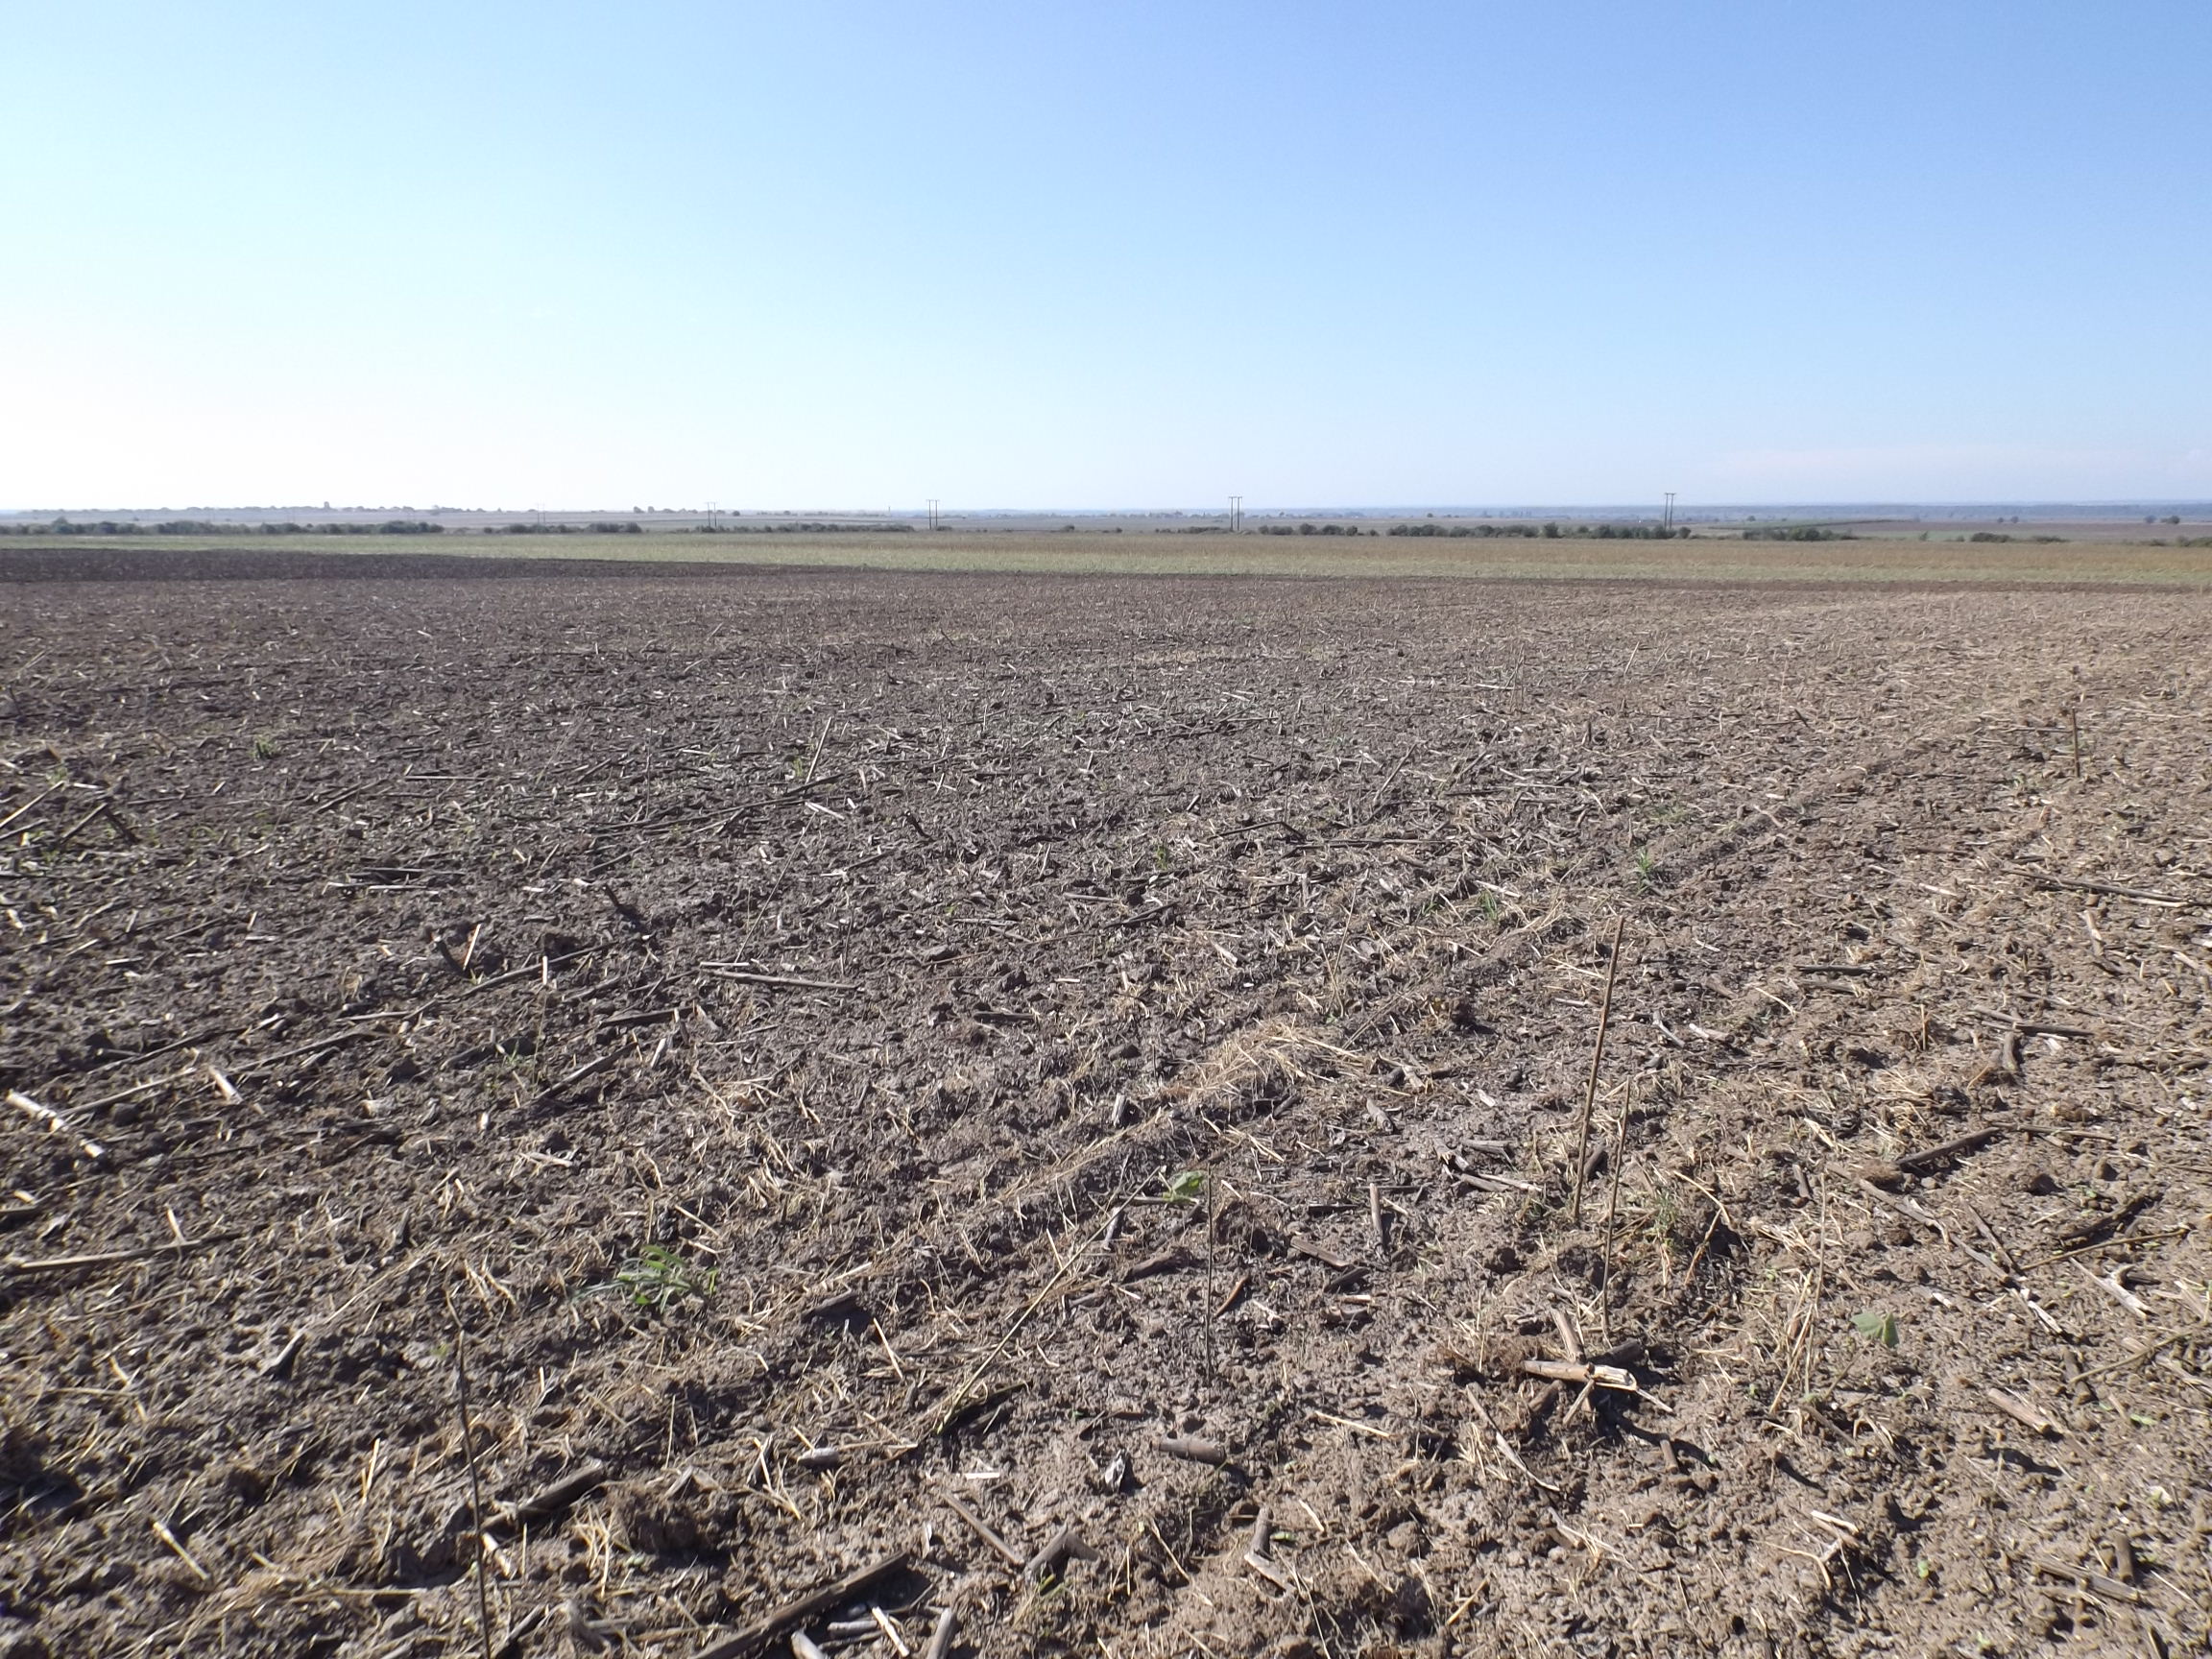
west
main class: Cropland
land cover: Sunflower
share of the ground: < 10 %
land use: Agriculture (excluding fallow land and kitchen gardens)
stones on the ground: < 10 %
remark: Harvested field
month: September
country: BG
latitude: 43.9916
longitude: 26.5073
